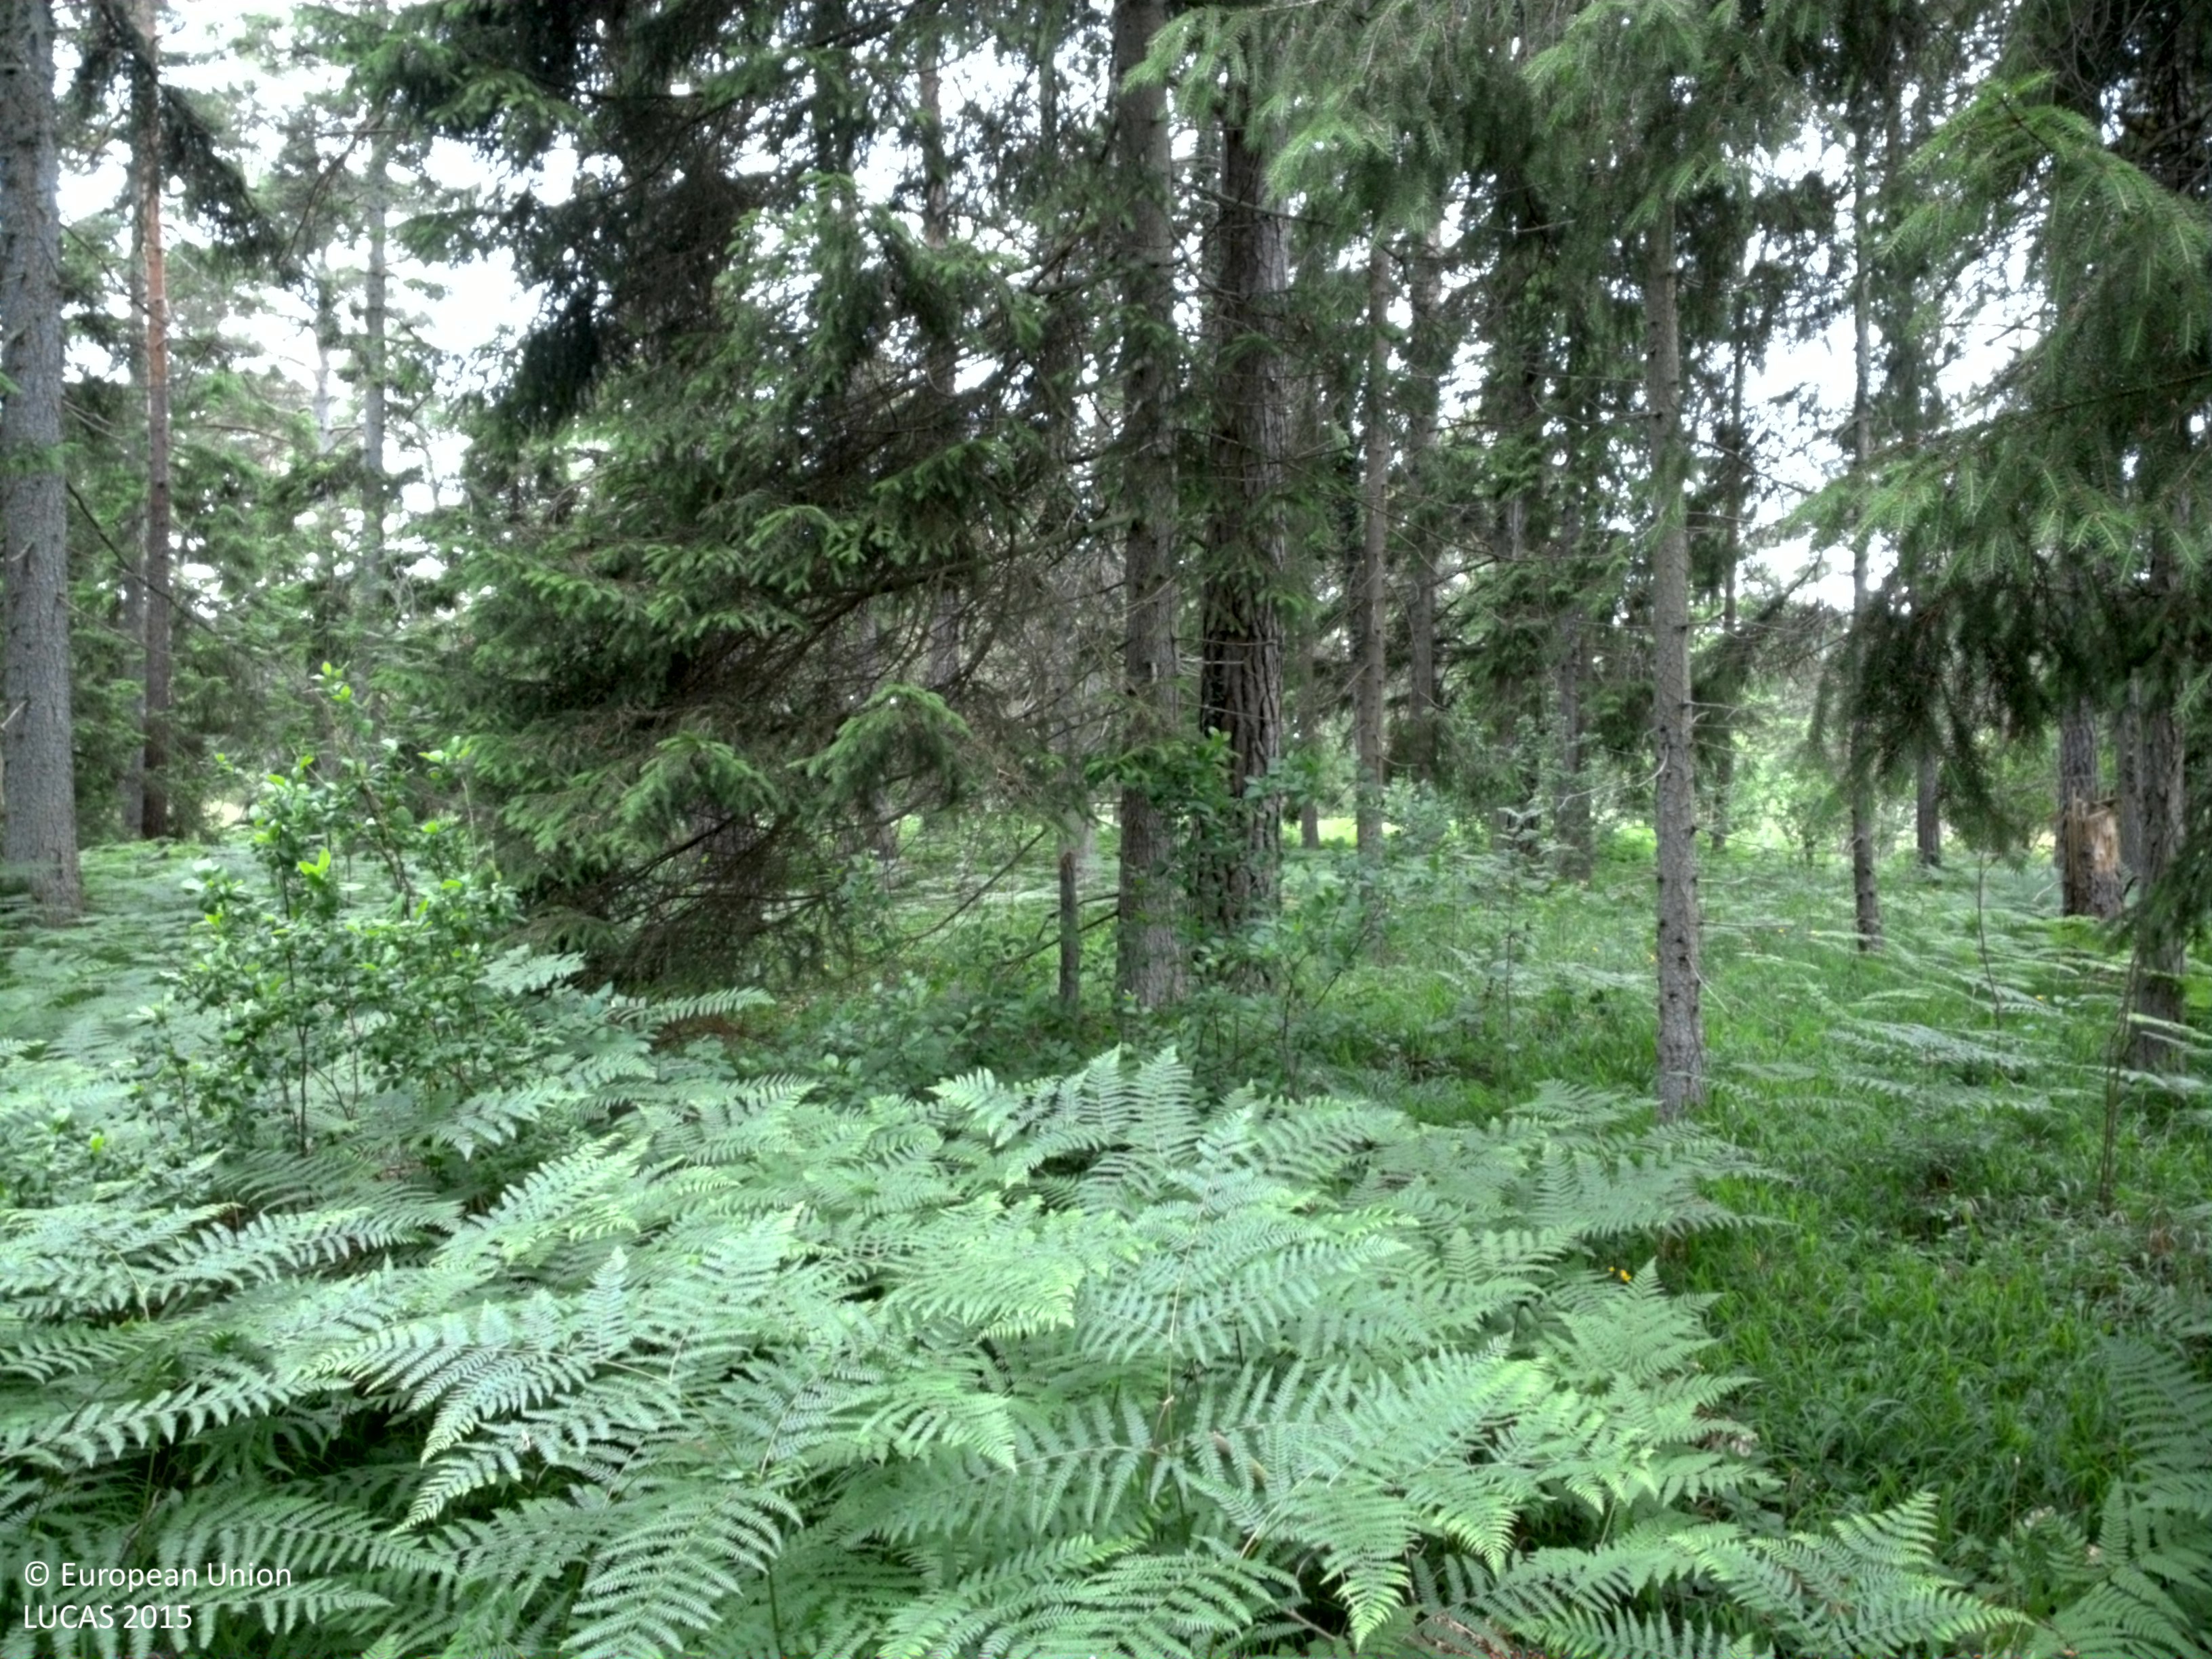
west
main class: Woodland
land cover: Spruce dominated coniferous woodland
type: hemiboreal forest and nemoral coniferous forest and mixed broadleaved-coniferous forest
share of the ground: 50 - 75 %
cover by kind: coniferous forest trees 65 %, herbaceous plants 30 %, shrubs 5 %
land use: Community services
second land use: Forestry
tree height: > 5 m
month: July
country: SE
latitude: 57.5540
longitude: 18.1786
